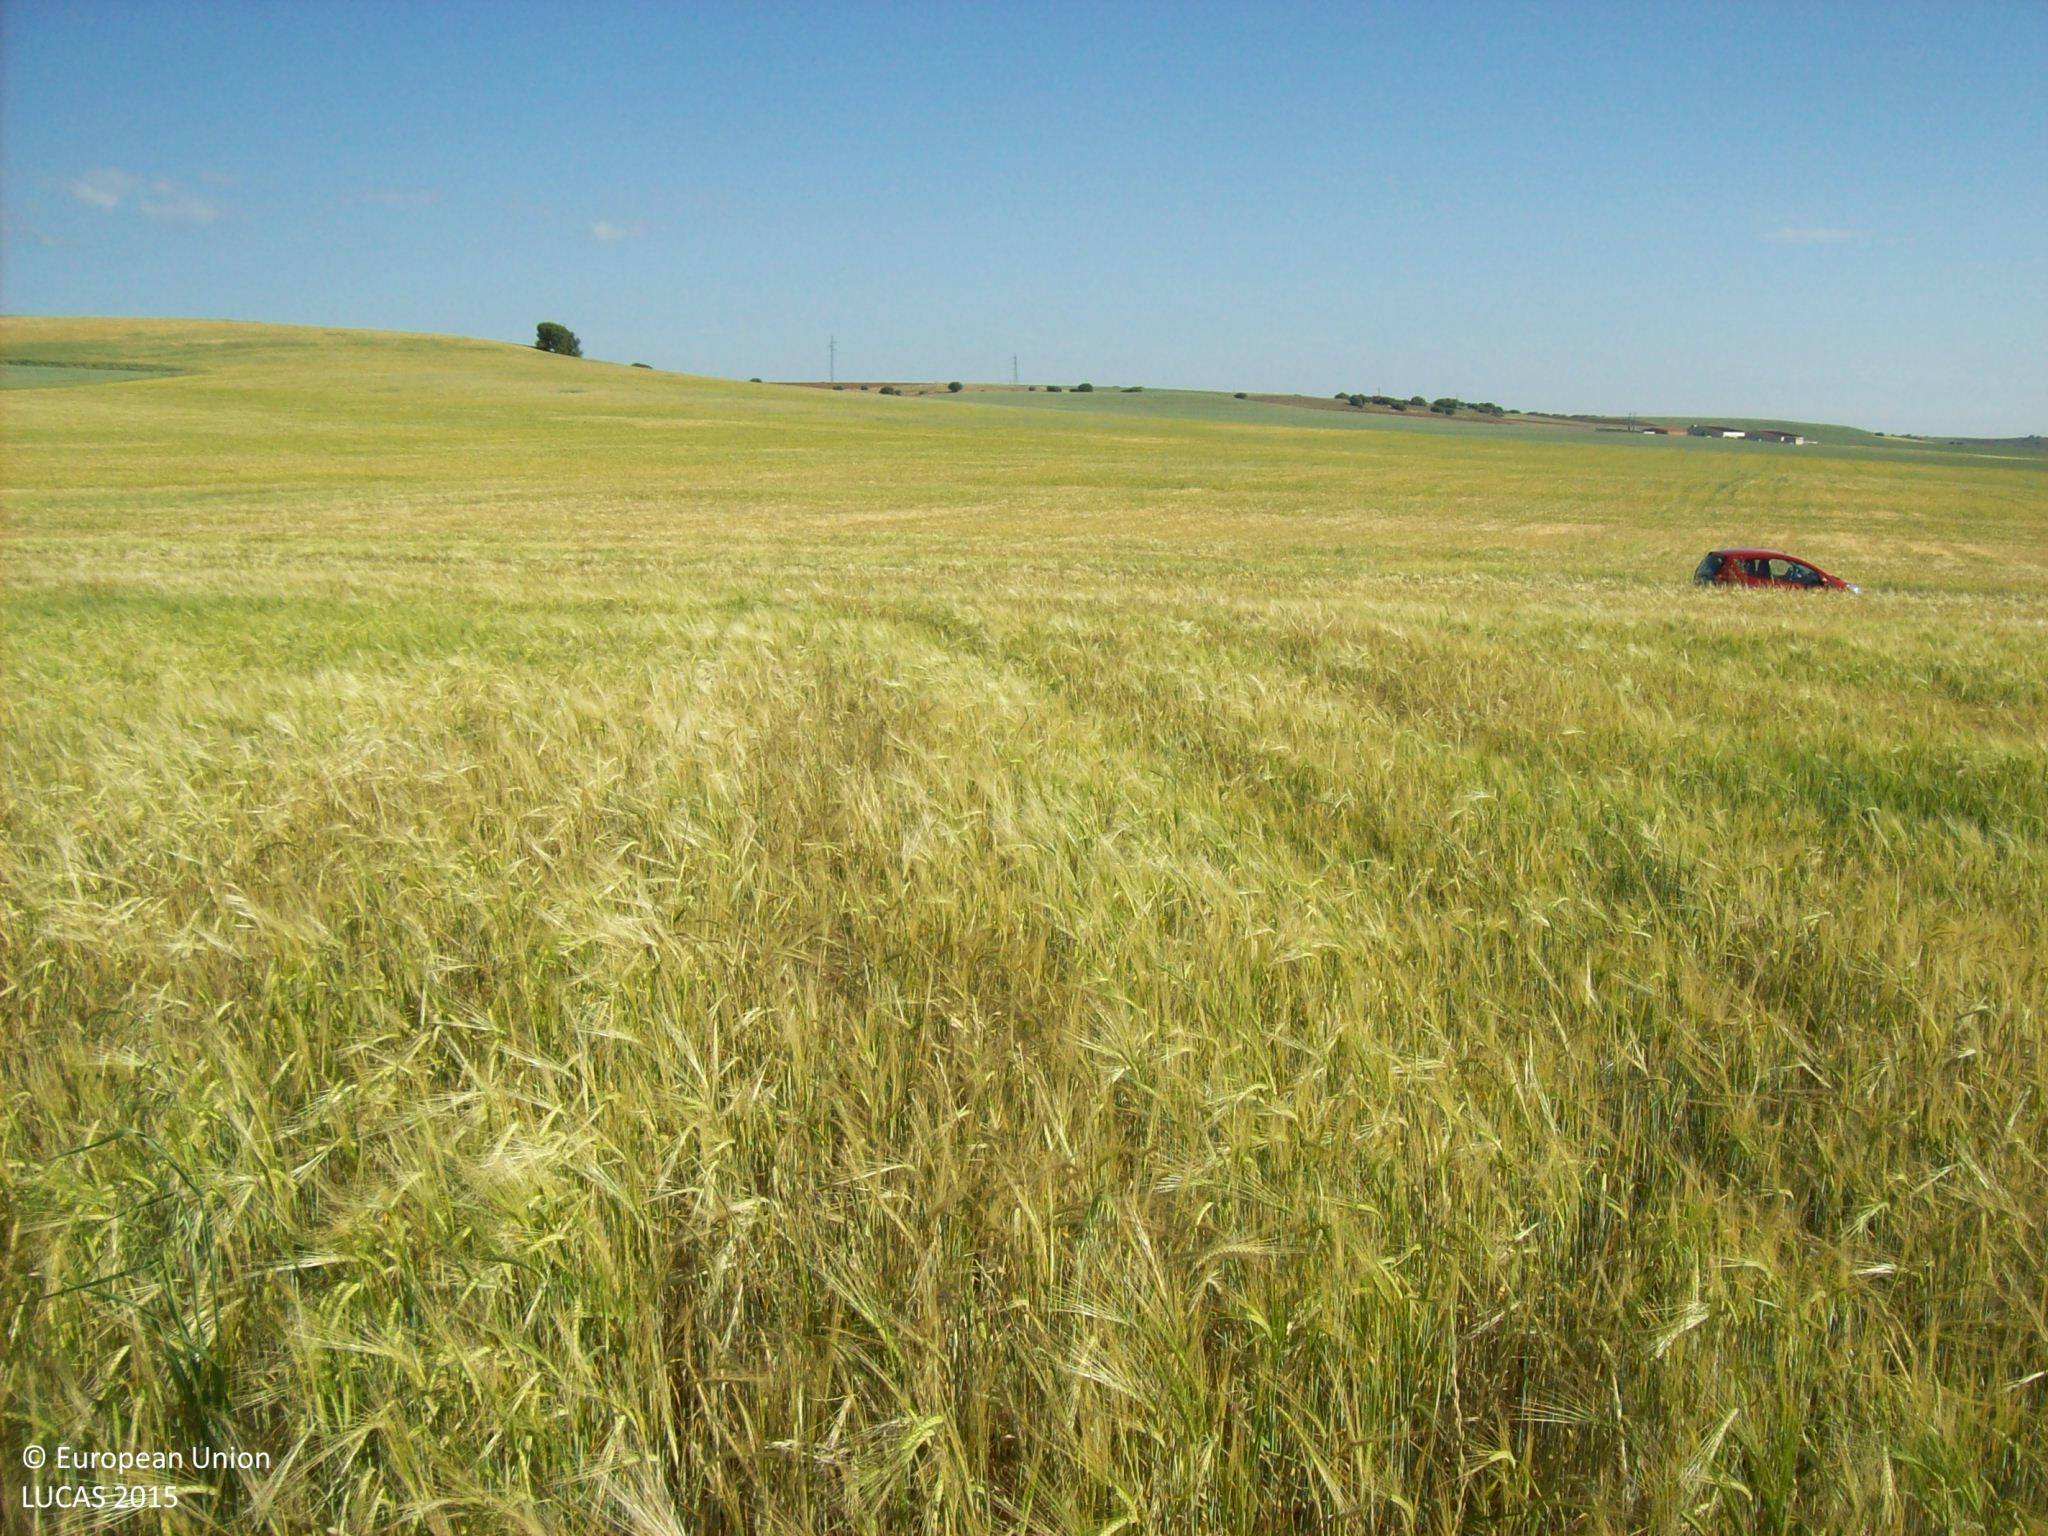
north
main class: Cropland
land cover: Barley
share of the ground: > 75 %
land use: Agriculture (excluding fallow land and kitchen gardens)
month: May
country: ES
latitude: 40.9428
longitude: -4.5121
